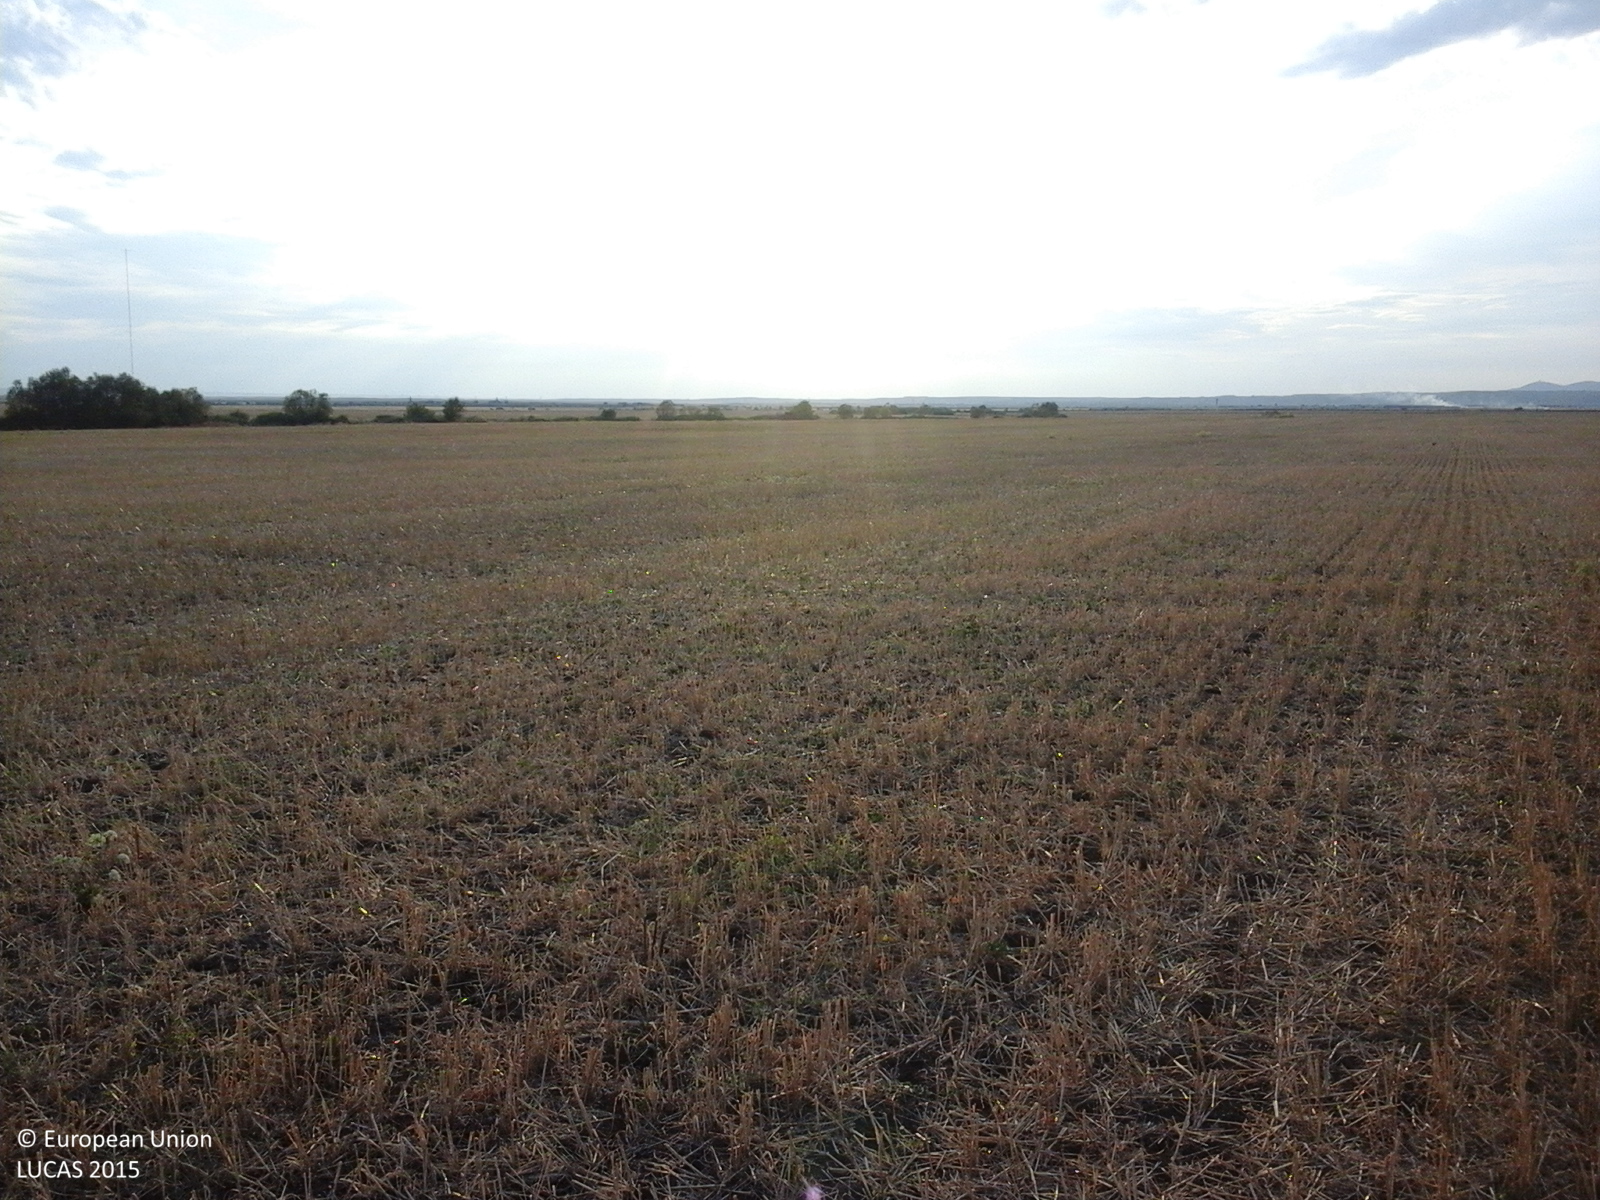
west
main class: Cropland
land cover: Durum wheat
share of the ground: > 75 %
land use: Agriculture (excluding fallow land and kitchen gardens)
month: August
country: RO
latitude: 45.0122
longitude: 21.5639
